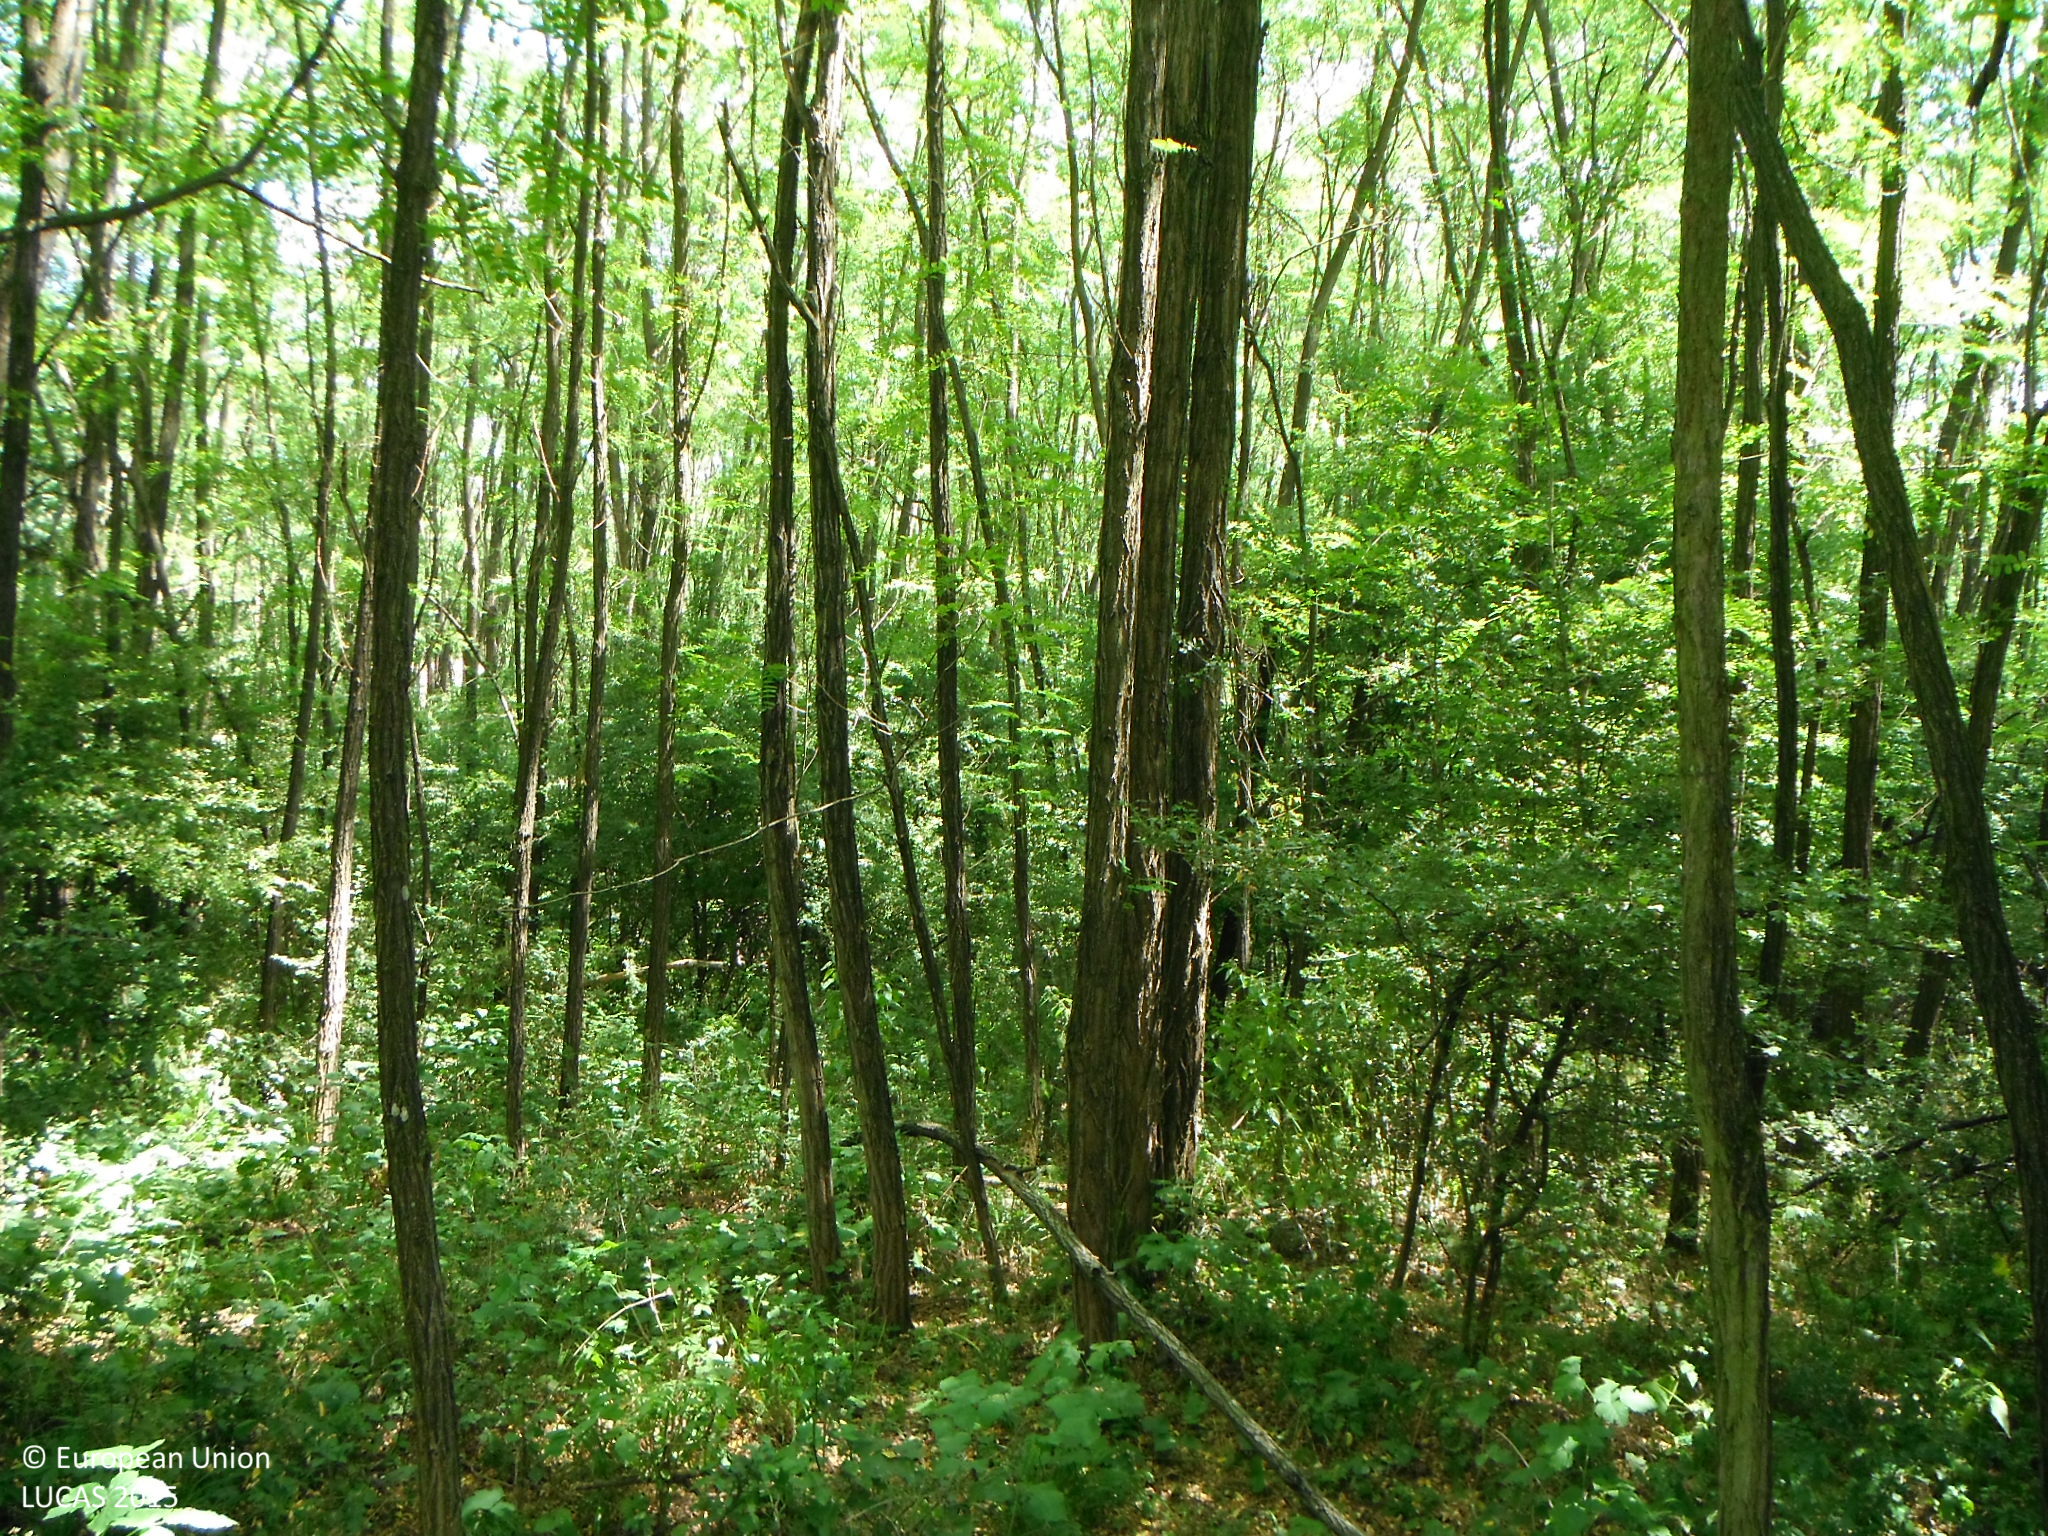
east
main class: Woodland
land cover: Broadleaved woodland
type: mesophytic deciduous forest
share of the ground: > 75 %
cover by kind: broadleaved forest trees 100 %
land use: Forestry
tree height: > 5 m
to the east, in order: Broadleaved woodland; Grassland without tree/shrub cover; Ditches and canals; Broadleaved woodland; Fences; Tracks; Fences; Grassland without tree/shrub cover; Cherry fruit; Grassland without tree/shrub cover
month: July
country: SK
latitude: 48.2596
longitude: 19.1404
